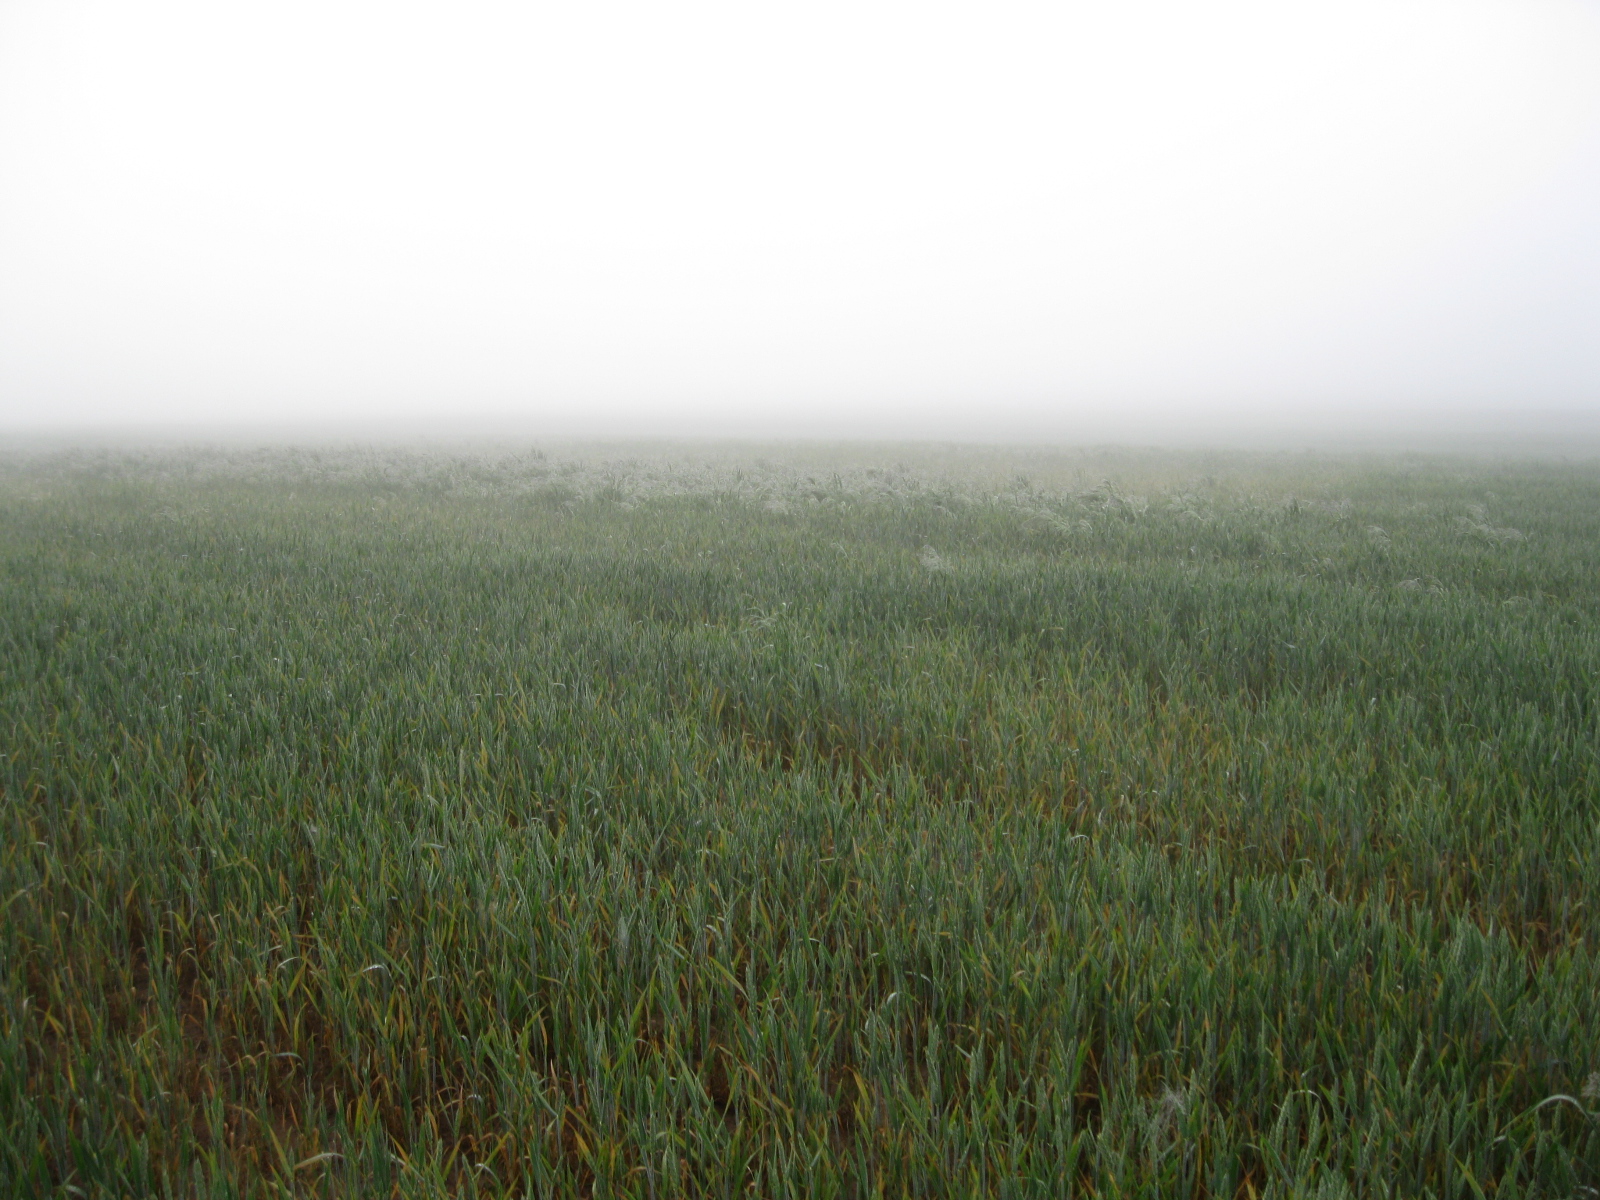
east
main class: Cropland
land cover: Common wheat
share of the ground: > 75 %
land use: Agriculture (excluding fallow land and kitchen gardens)
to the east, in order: Common wheat; Spontaneously vegetated surfaces; Ditches and canals; Shrubland with sparse tree cover; Common wheat
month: June
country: LT
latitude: 55.4353
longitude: 23.9814
